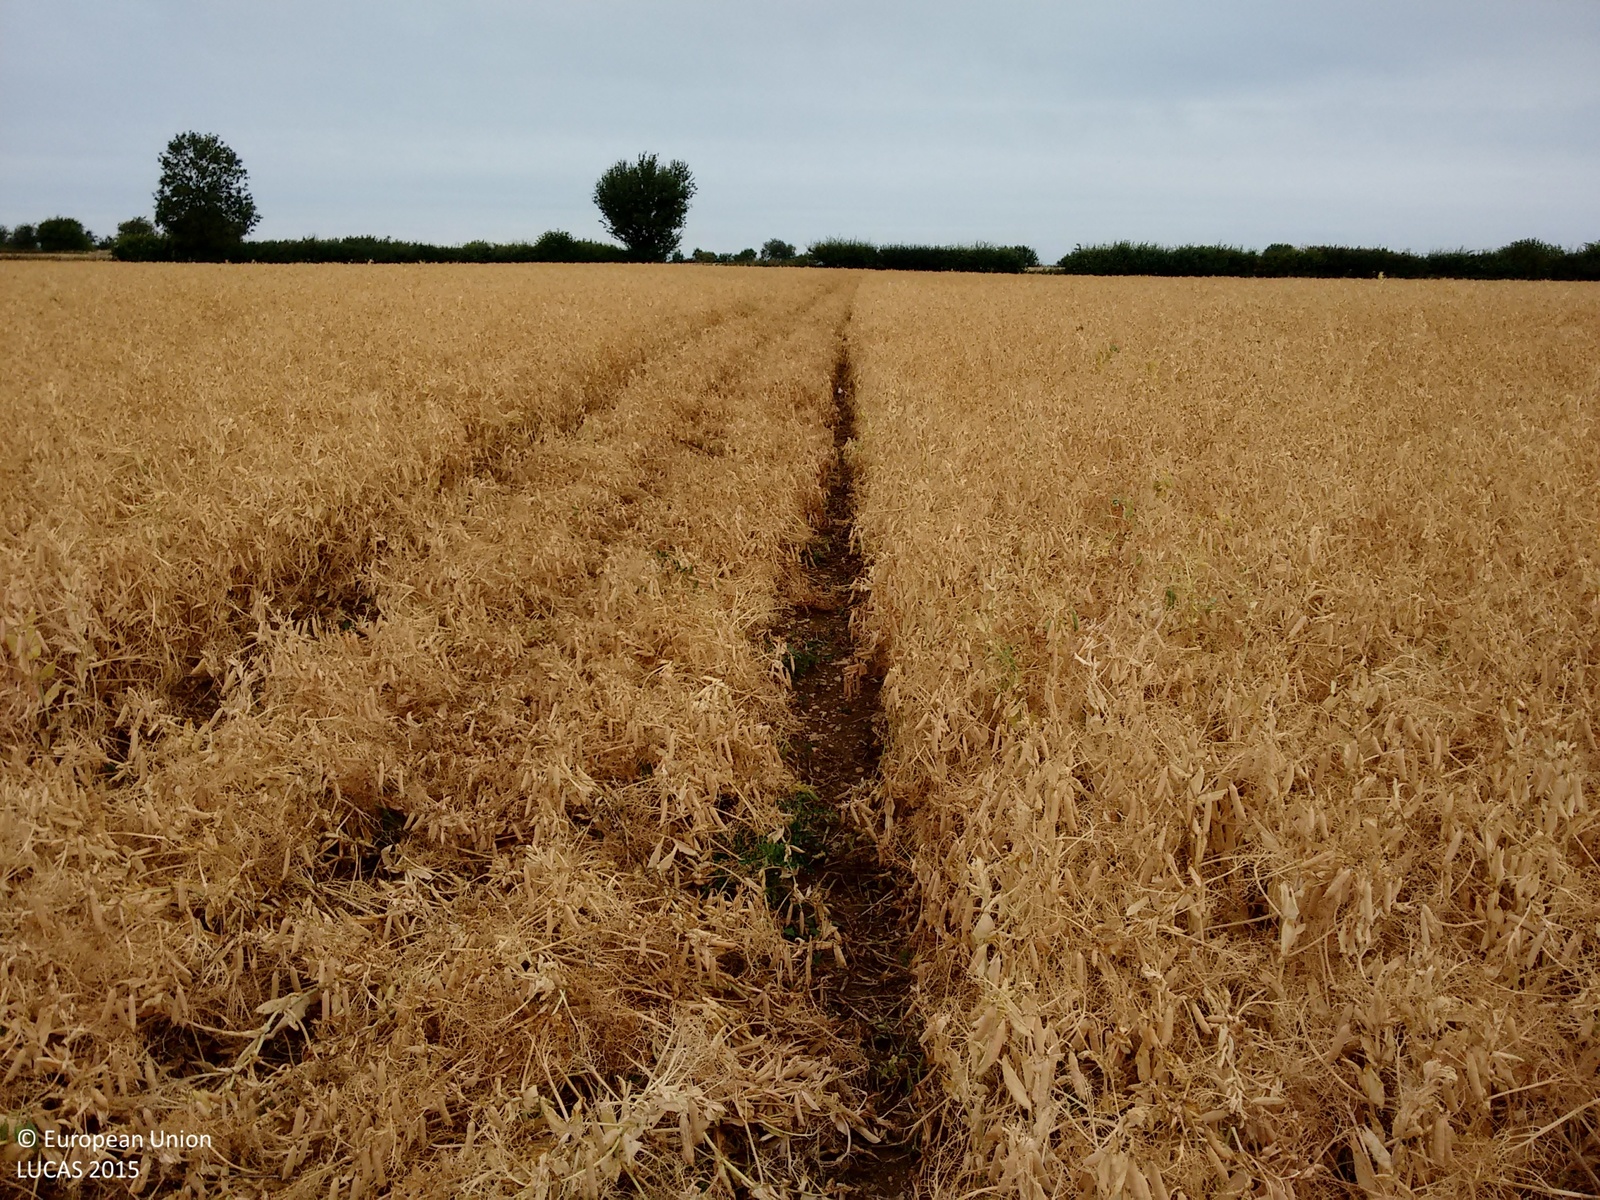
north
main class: Cropland
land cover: Dry pulses
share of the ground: > 75 %
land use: Agriculture (excluding fallow land and kitchen gardens)
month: August
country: GB
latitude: 52.0275
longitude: -1.1967
